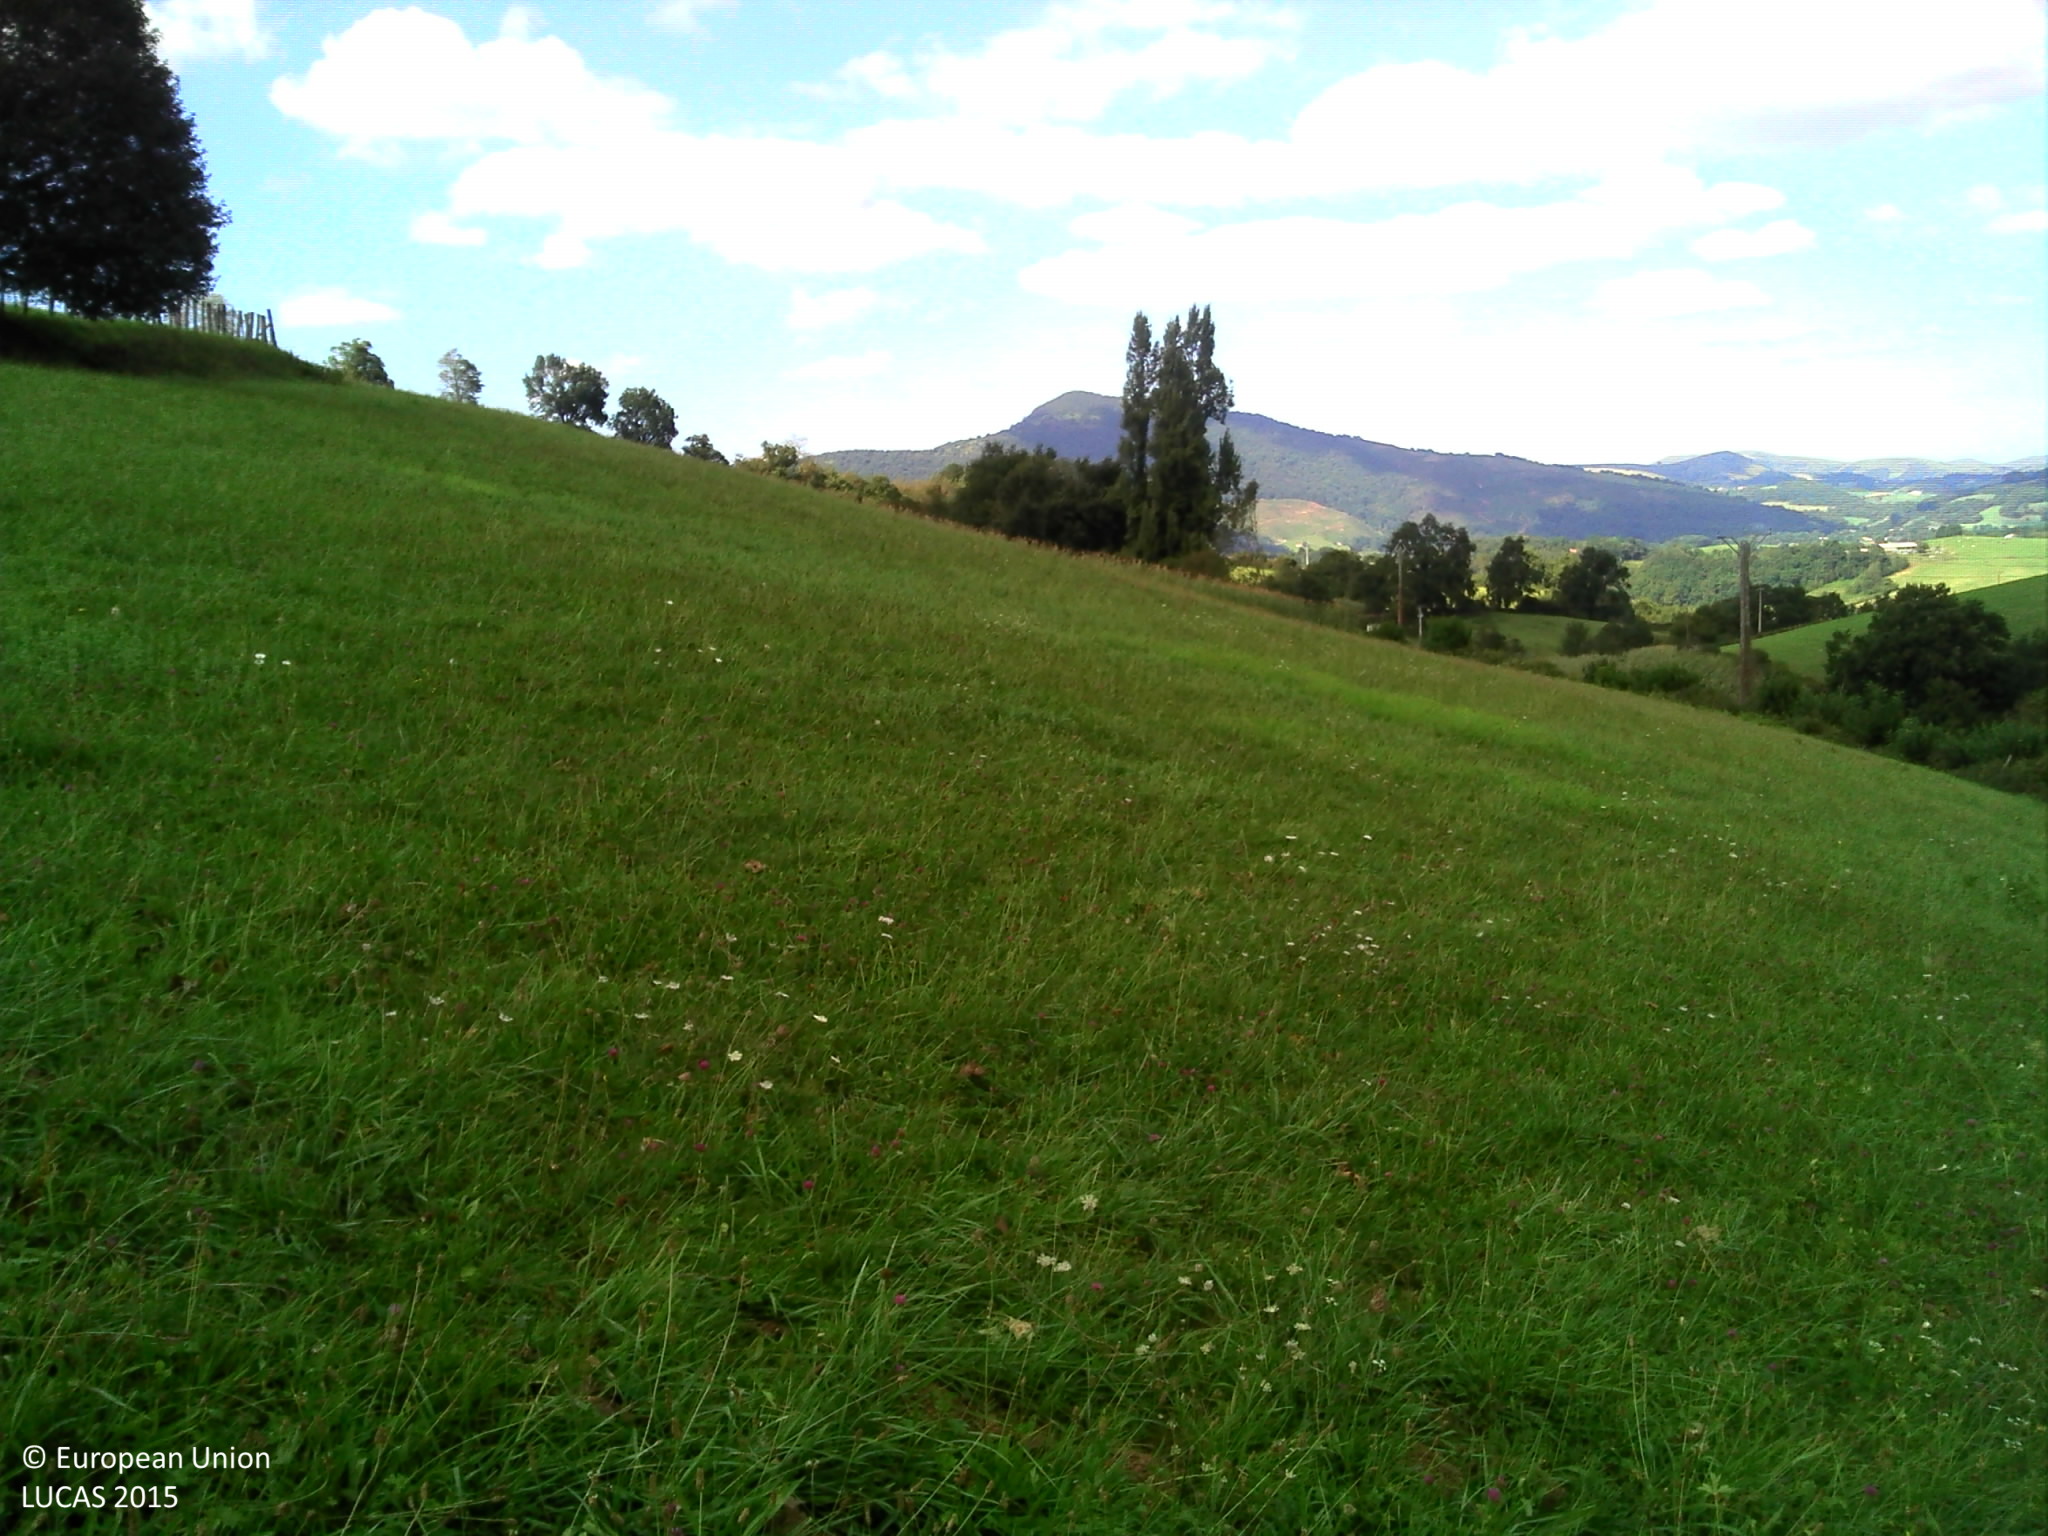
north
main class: Grassland
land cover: Grassland without tree/shrub cover
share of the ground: > 75 %
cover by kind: herbaceous plants 100 %
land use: Agriculture (excluding fallow land and kitchen gardens)
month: September
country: FR
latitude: 43.1375
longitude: -1.2378
